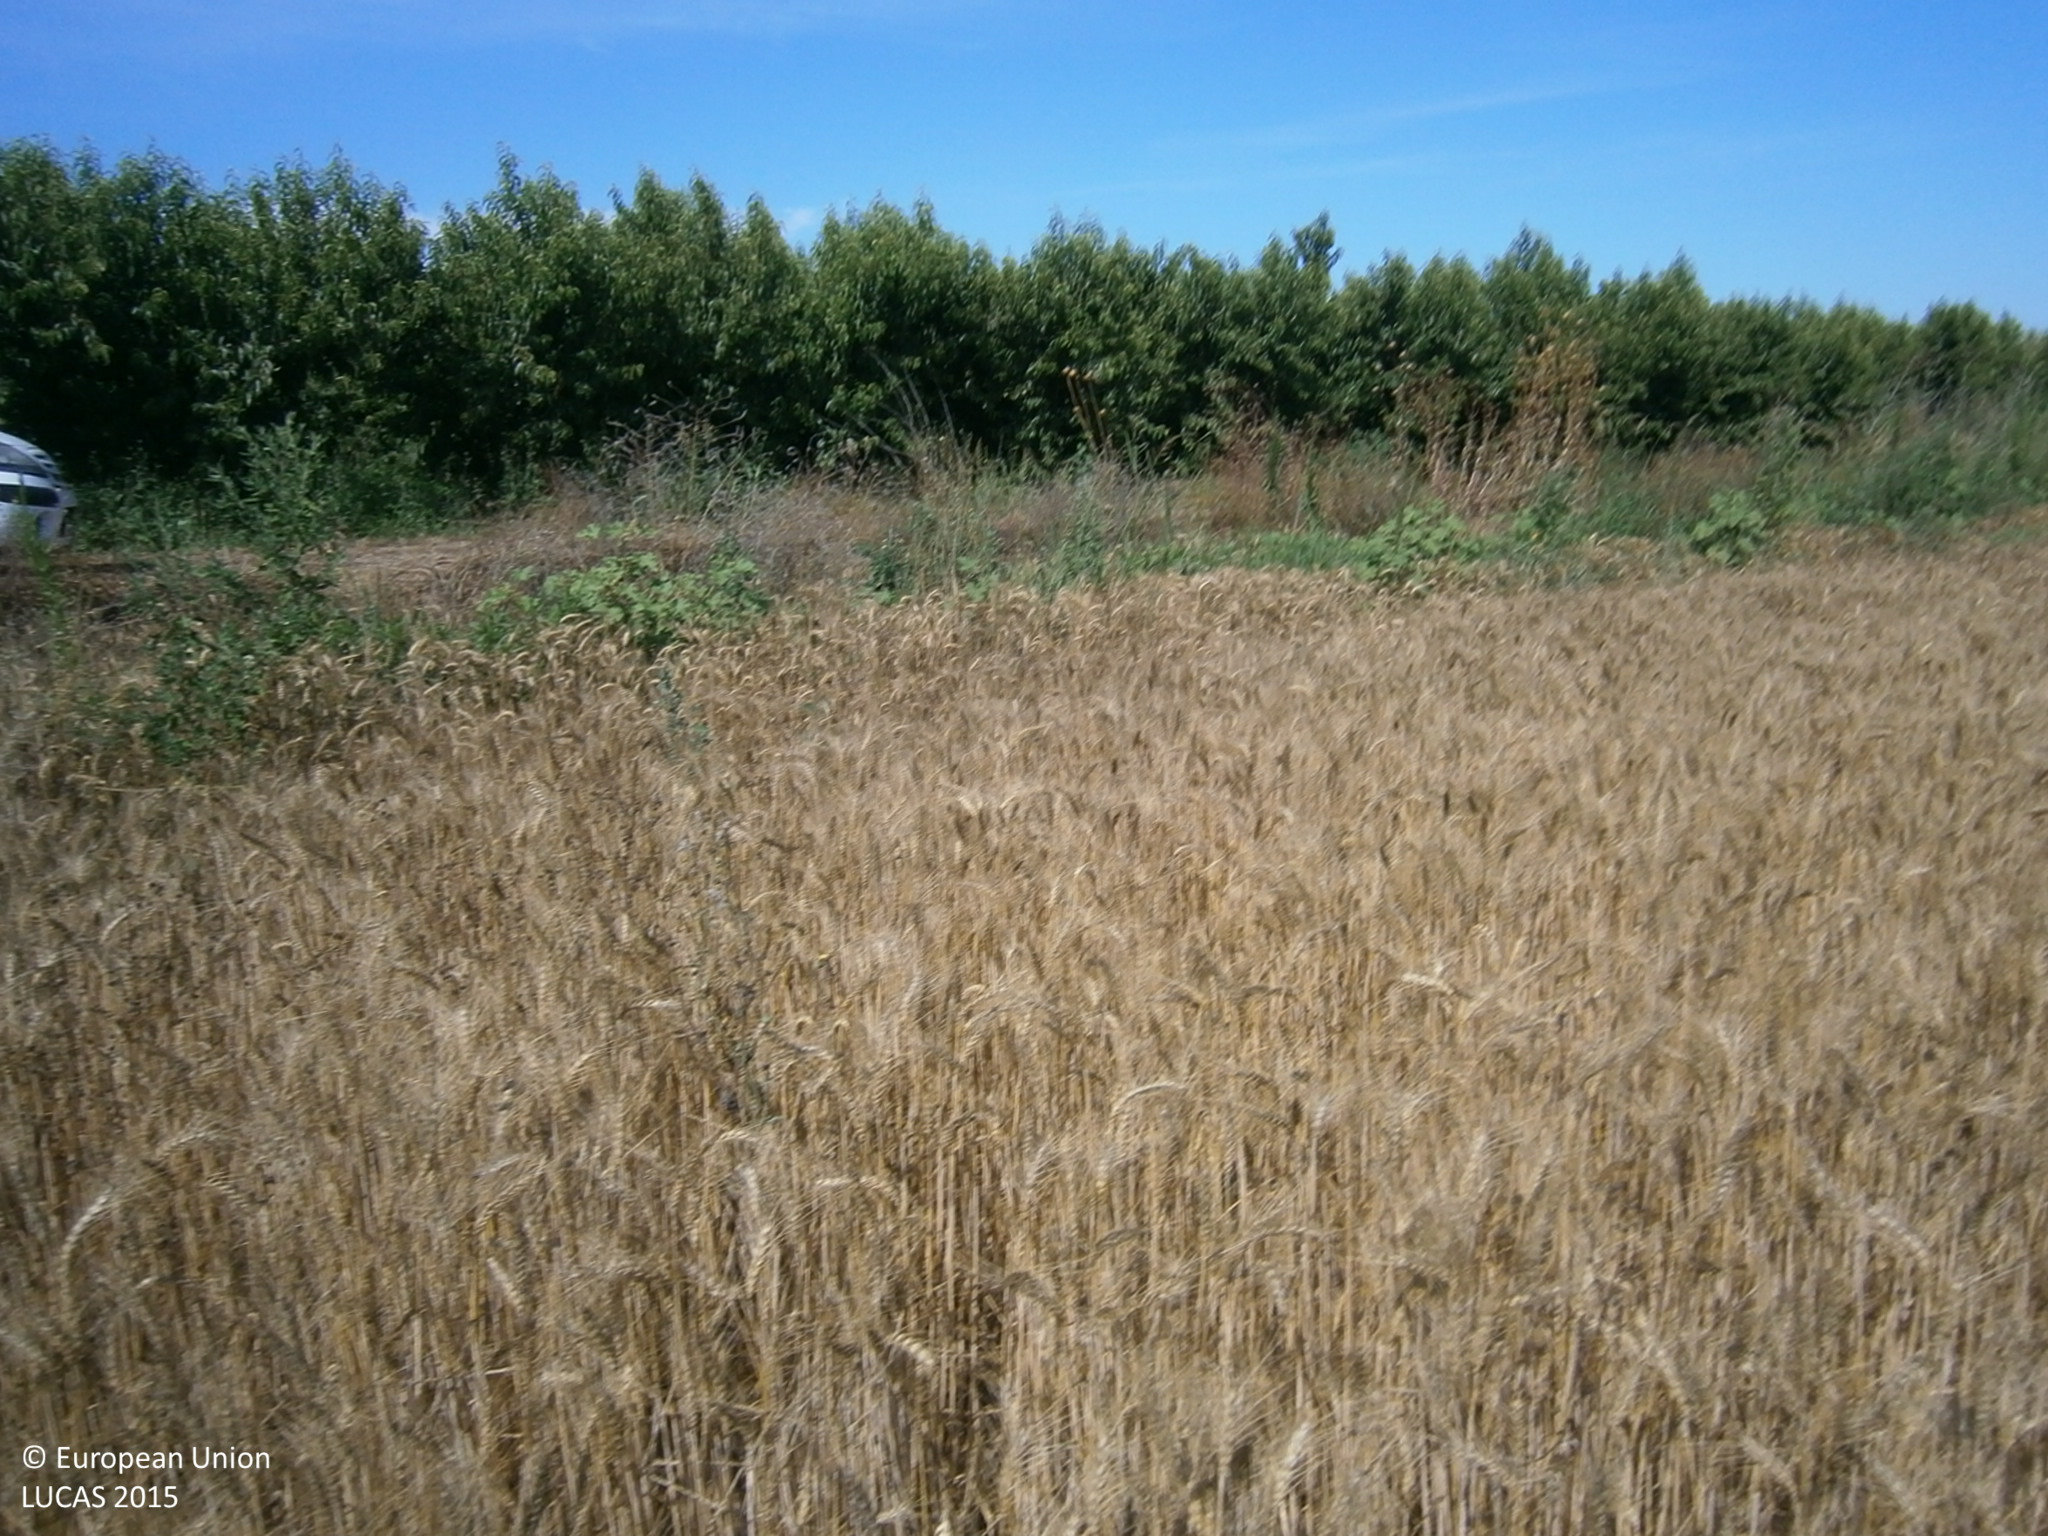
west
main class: Cropland
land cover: Durum wheat
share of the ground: > 75 %
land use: Agriculture (excluding fallow land and kitchen gardens)
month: June
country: ES
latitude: 38.8724
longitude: -6.5313
